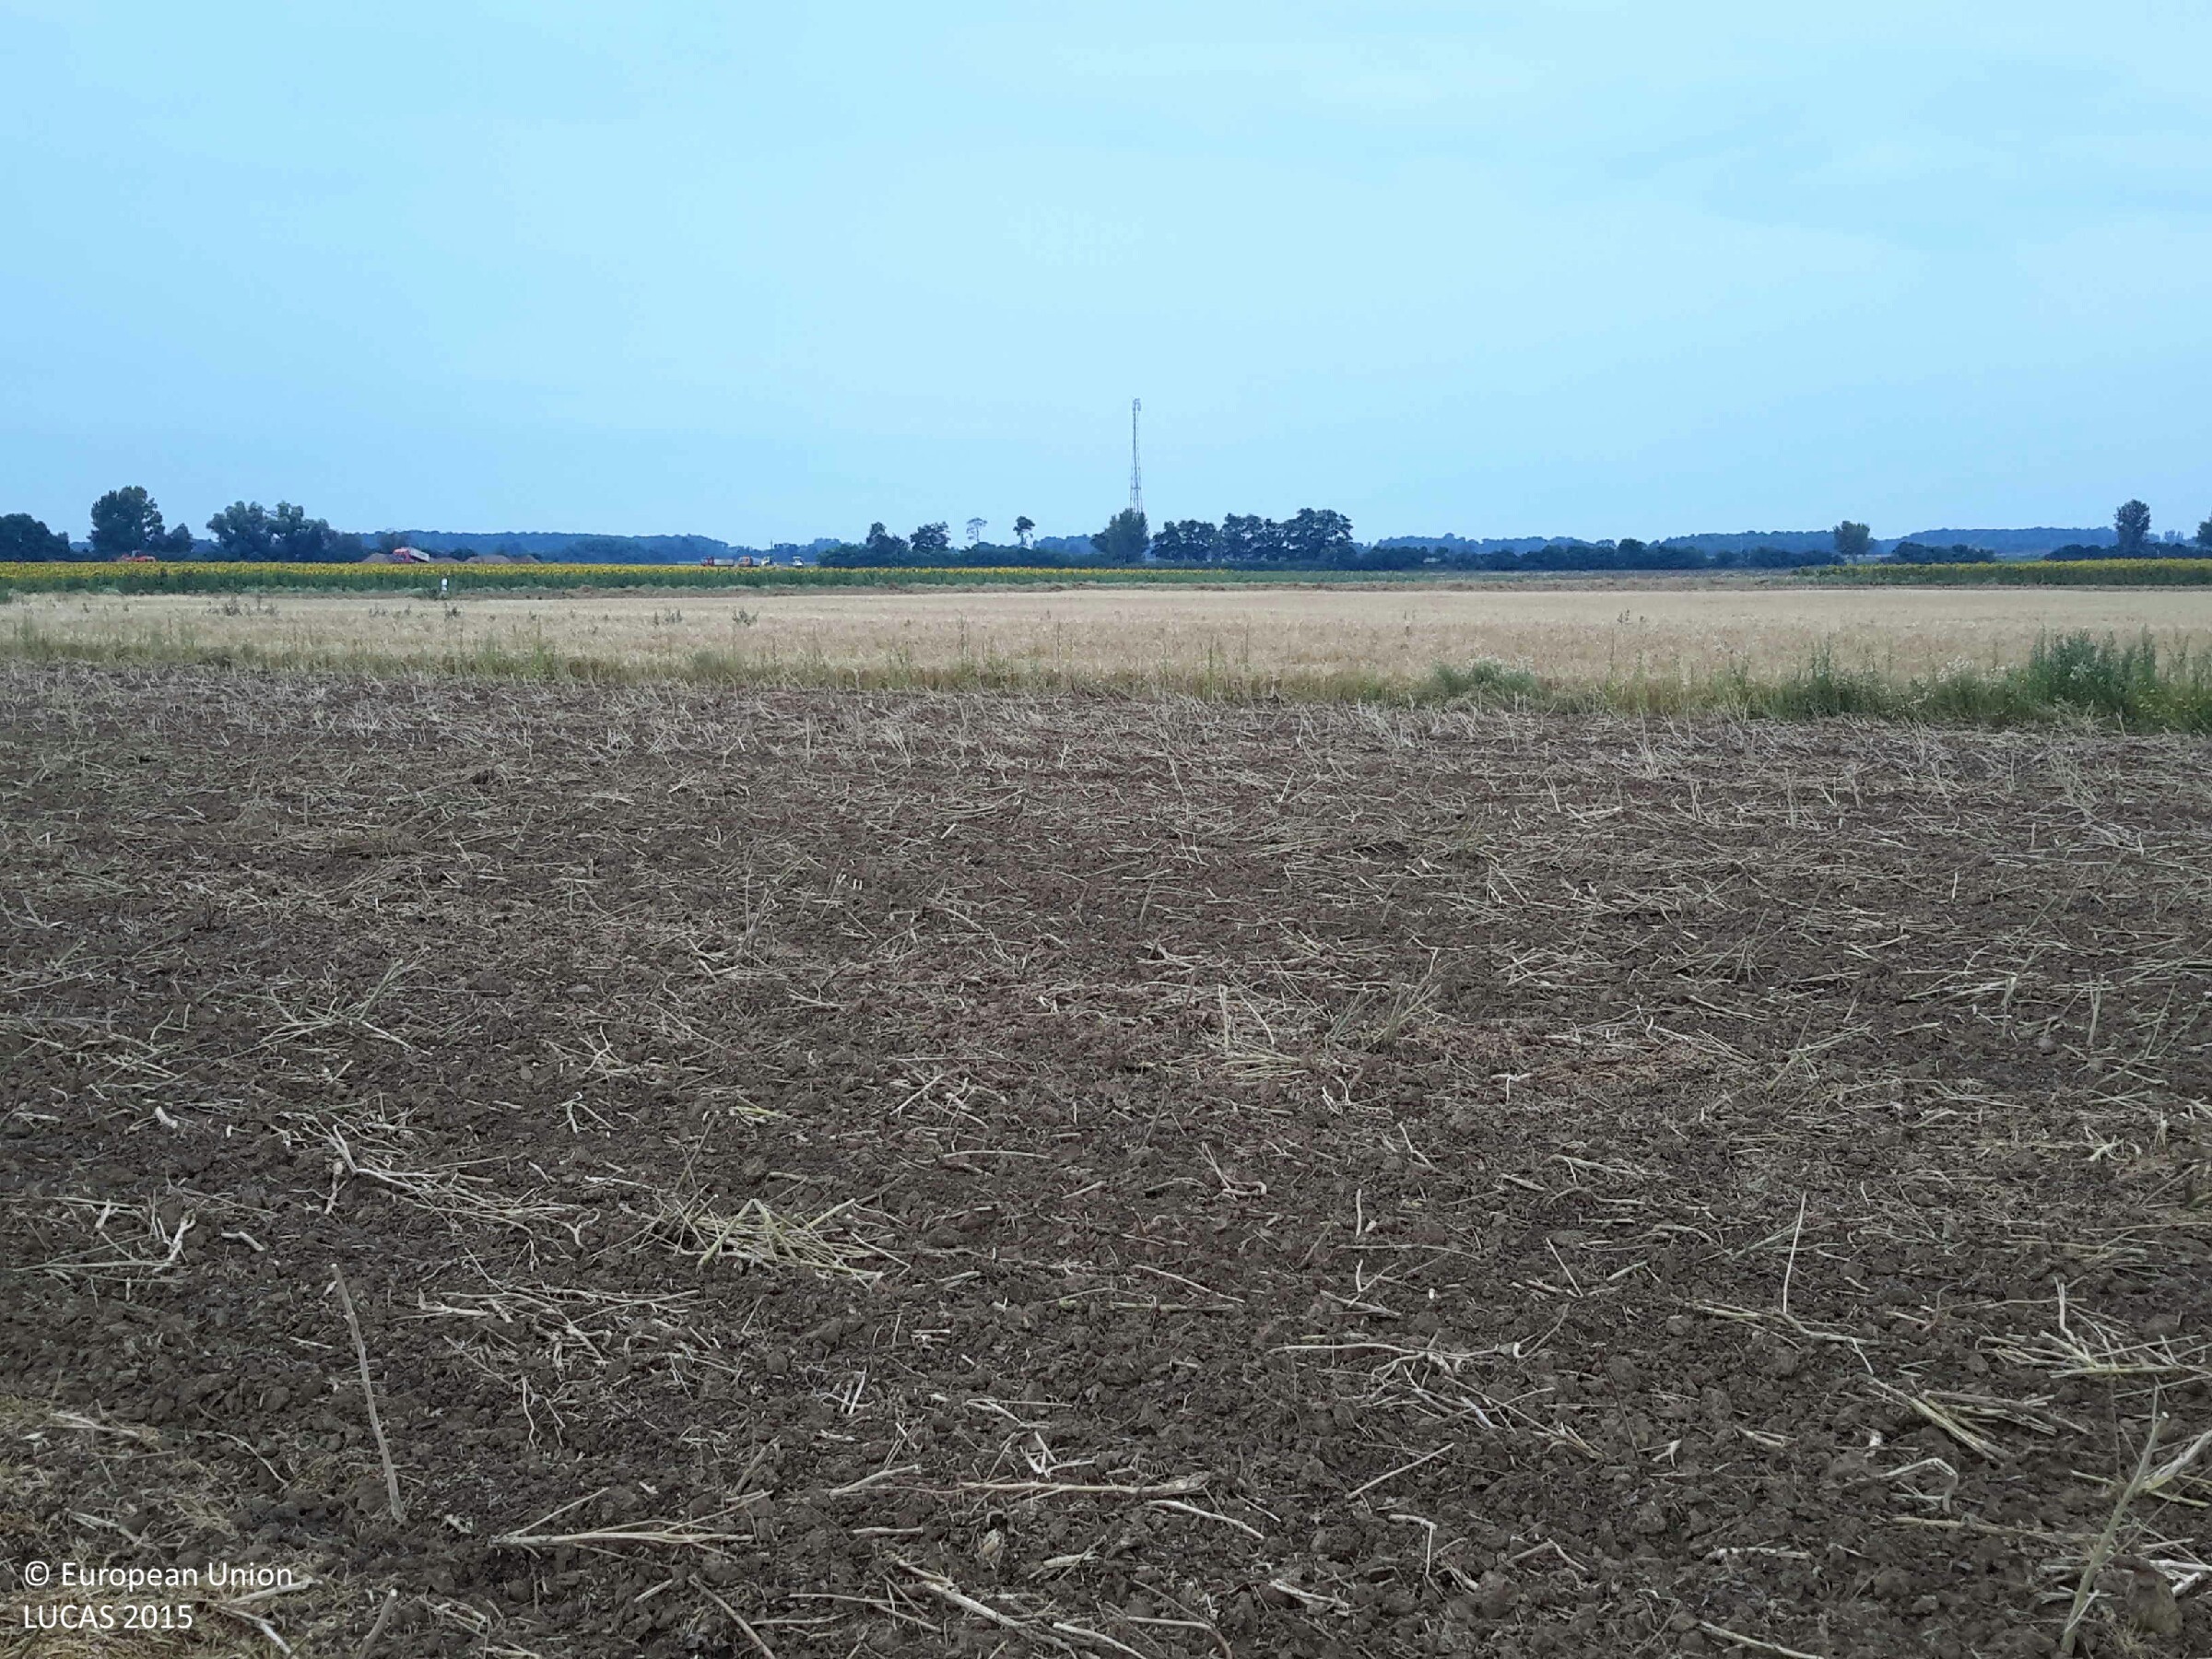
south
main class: Cropland
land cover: Common wheat
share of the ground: > 75 %
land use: Agriculture (excluding fallow land and kitchen gardens)
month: July
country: HU
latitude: 47.4362
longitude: 17.0730
